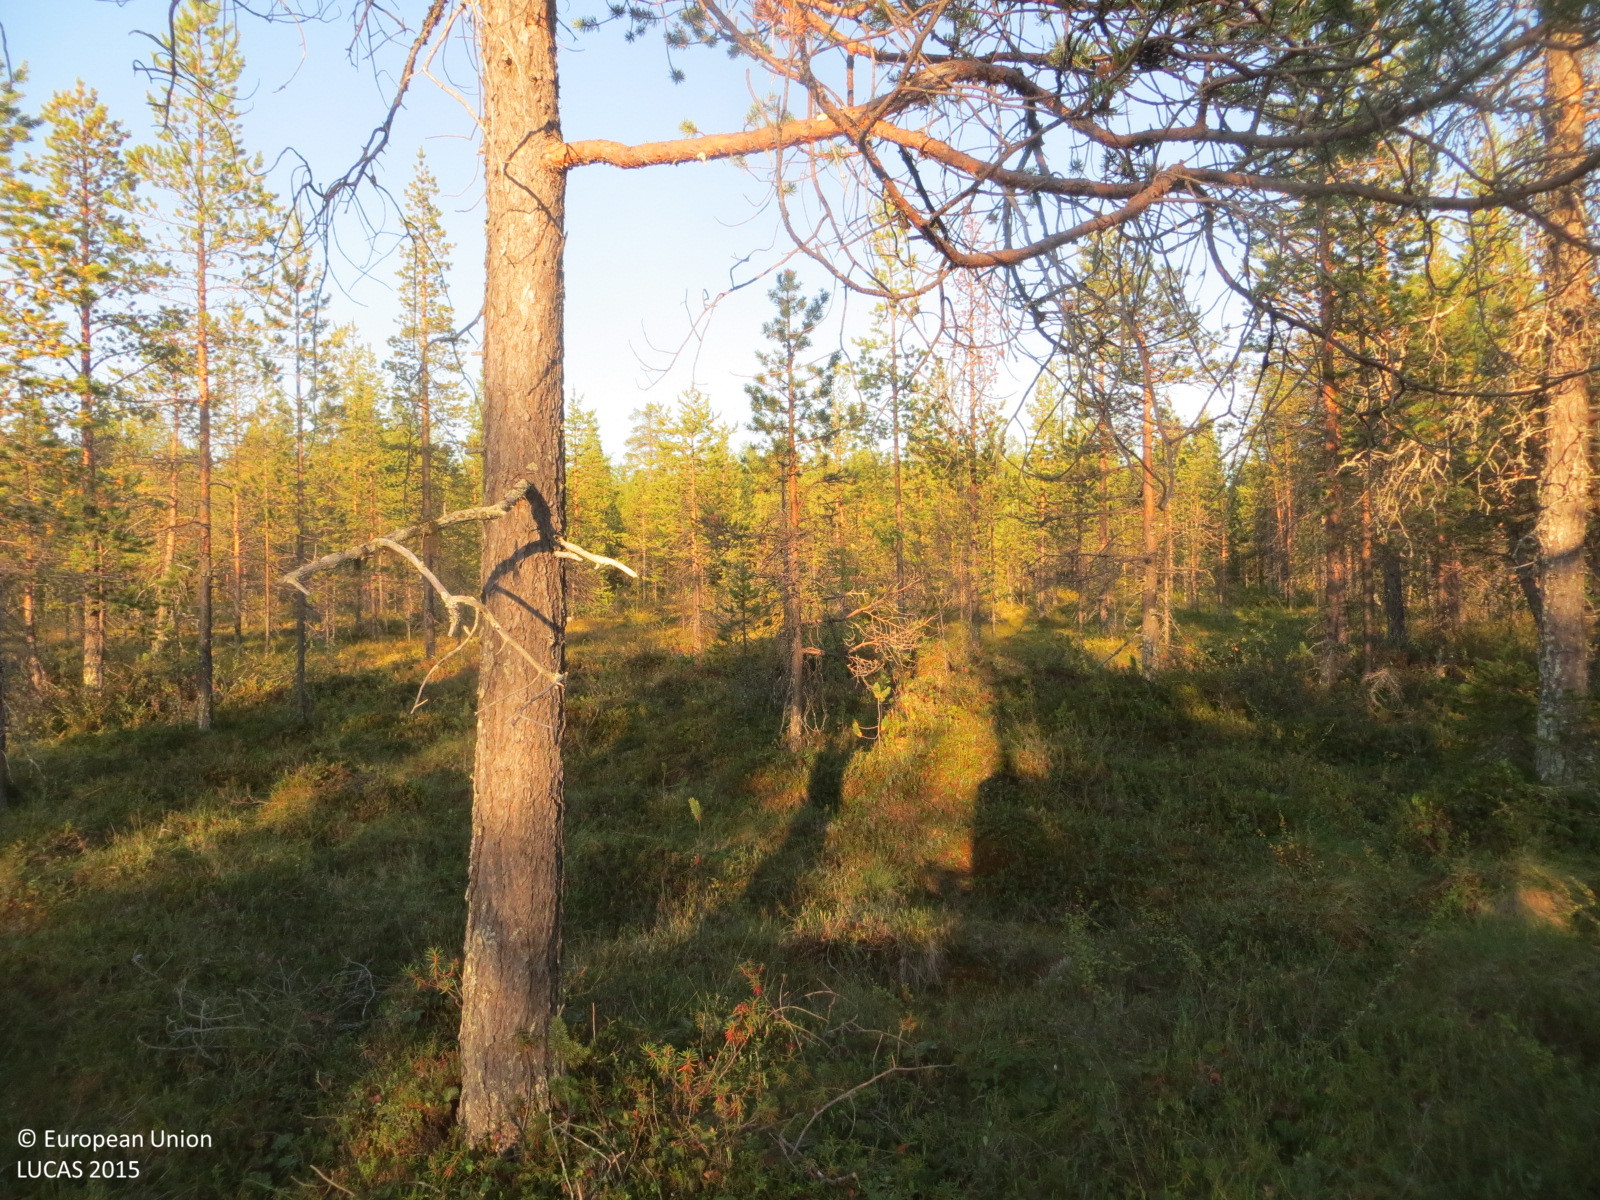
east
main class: Woodland
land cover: Pine dominated coniferous woodland
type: mire and swamp forests
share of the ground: 50 - 75 %
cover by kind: coniferous forest trees 50 %, shrubs 40 %, herbaceous plants 10 %
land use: Forestry
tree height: > 5 m
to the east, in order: Pine dominated coniferous woodland; Ditches and canals; Pine dominated coniferous woodland; Other mixed woodland; Pine dominated mixed woodland; Ditches and canals; Pine dominated mixed woodland; Pine dominated coniferous woodland
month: August
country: FI
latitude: 67.7373
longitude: 24.4788
